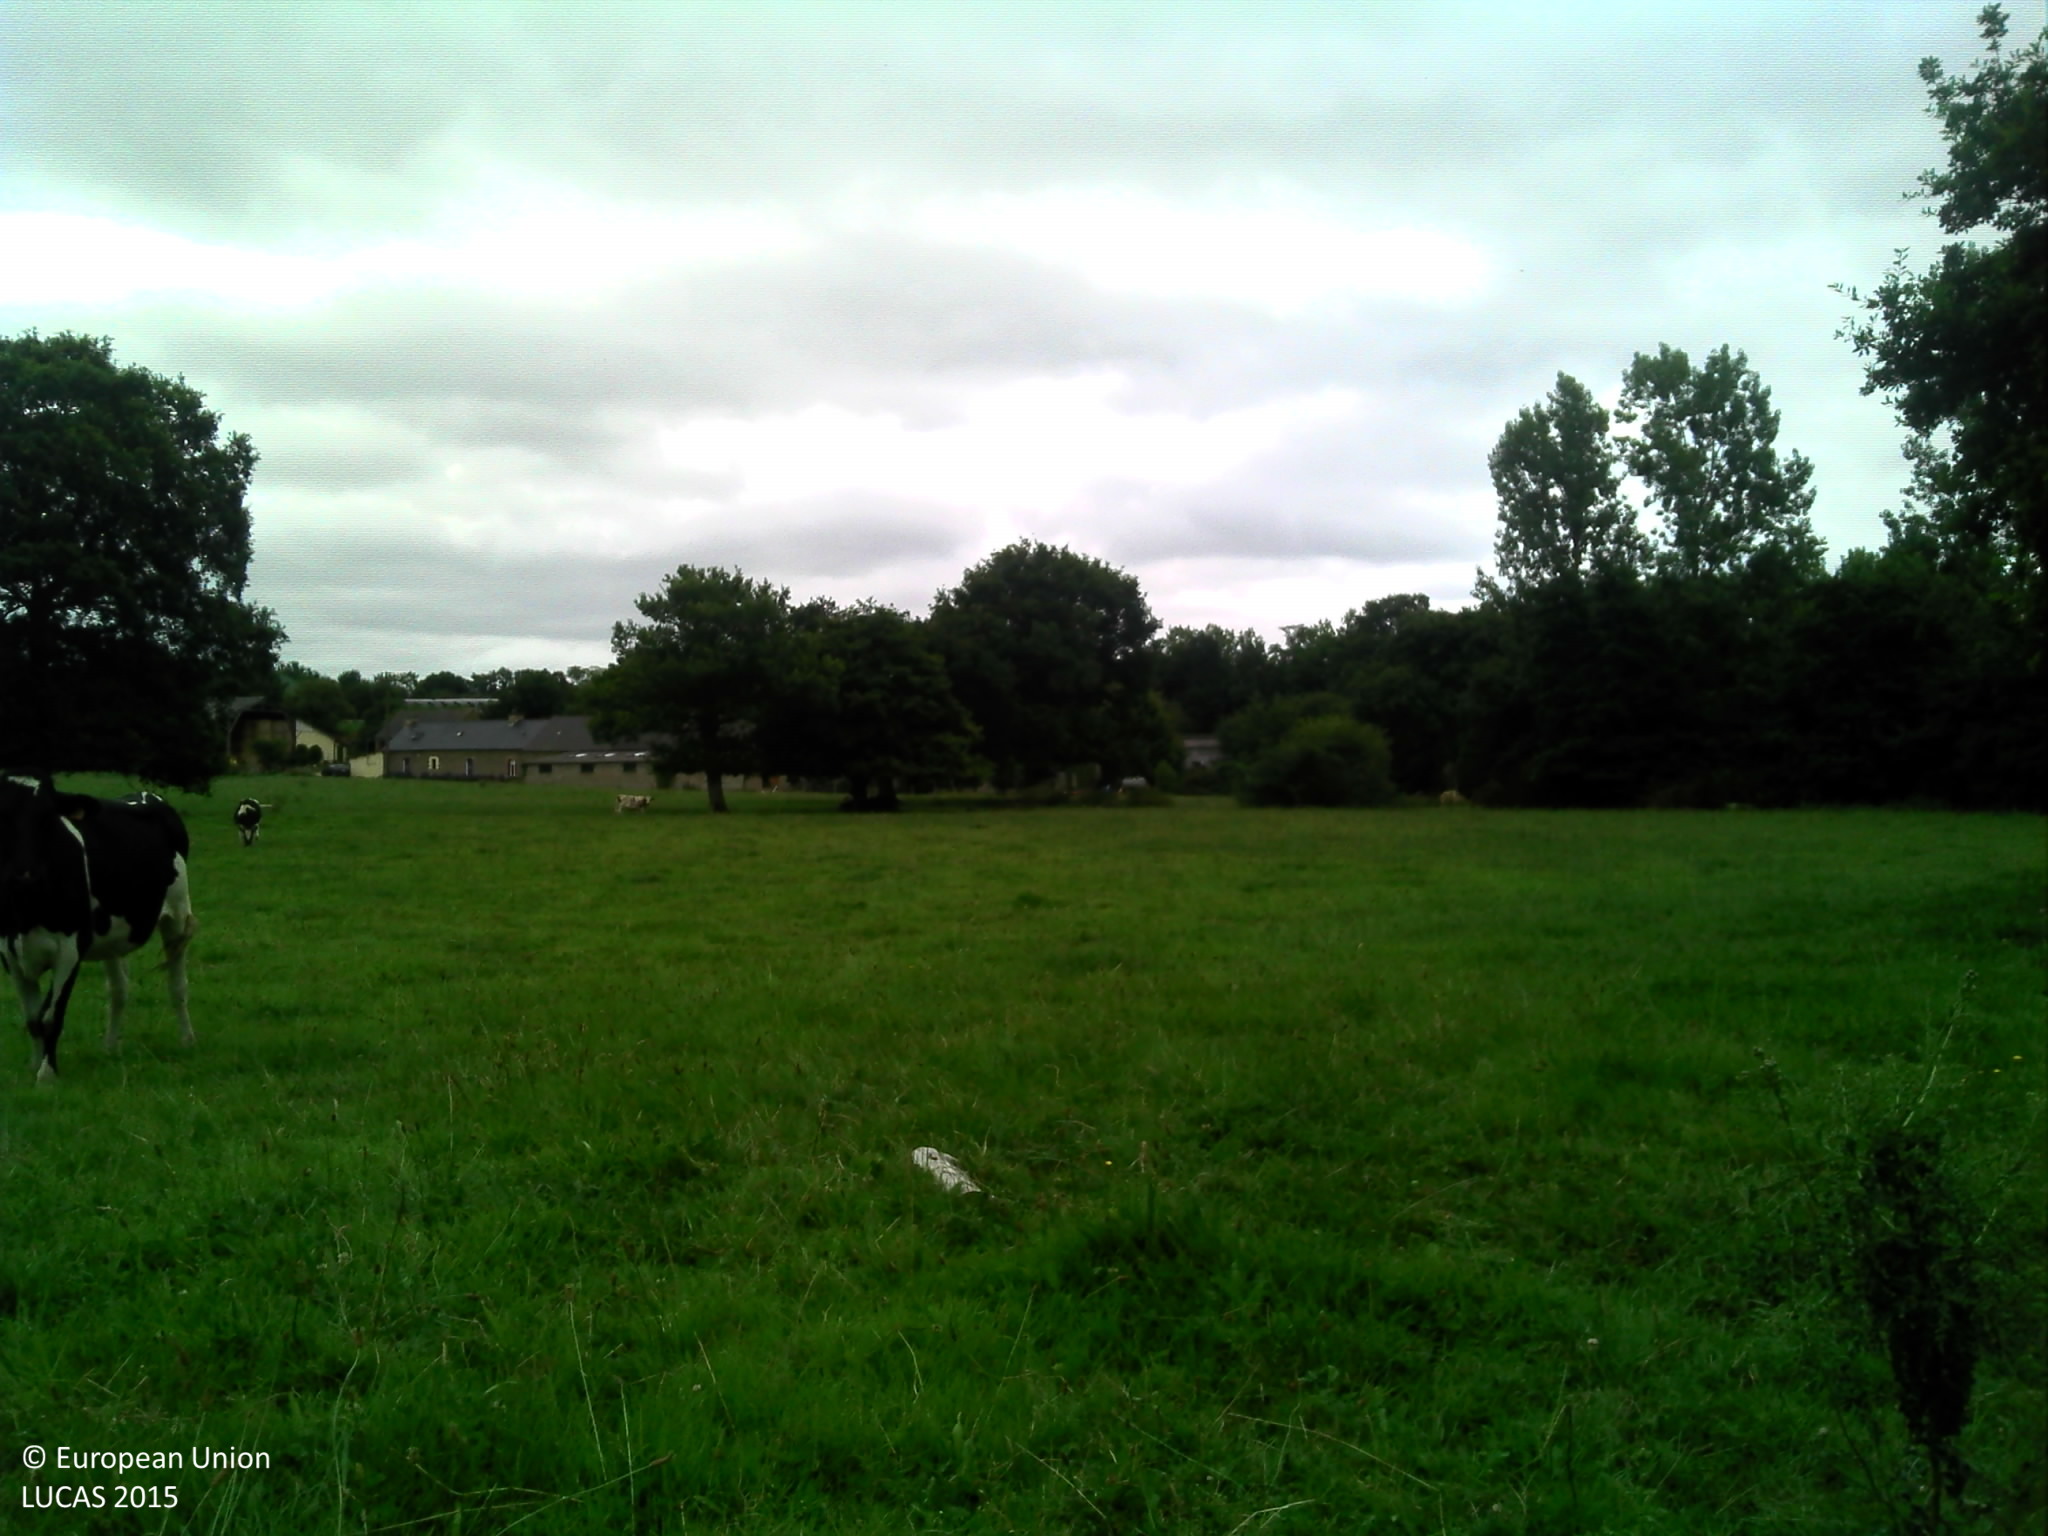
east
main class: Woodland
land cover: Broadleaved woodland
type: exotic forest
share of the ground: > 75 %
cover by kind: herbaceous plants 50 %, broadleaved forest trees 40 %, unconsolidated bare surface 10 %
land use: Forestry
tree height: > 5 m
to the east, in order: Broadleaved woodland; Grass margins; Rivers and streams; Grassland without tree/shrub cover; Electric lines; Fences; Grassland without tree/shrub cover; Fences; Lines of trees; Fences; Grassland without tree/shrub cover; Electric lines; Fences; Grassland without tree/shrub cover
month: July
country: FR
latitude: 48.4568
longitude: -2.4883
